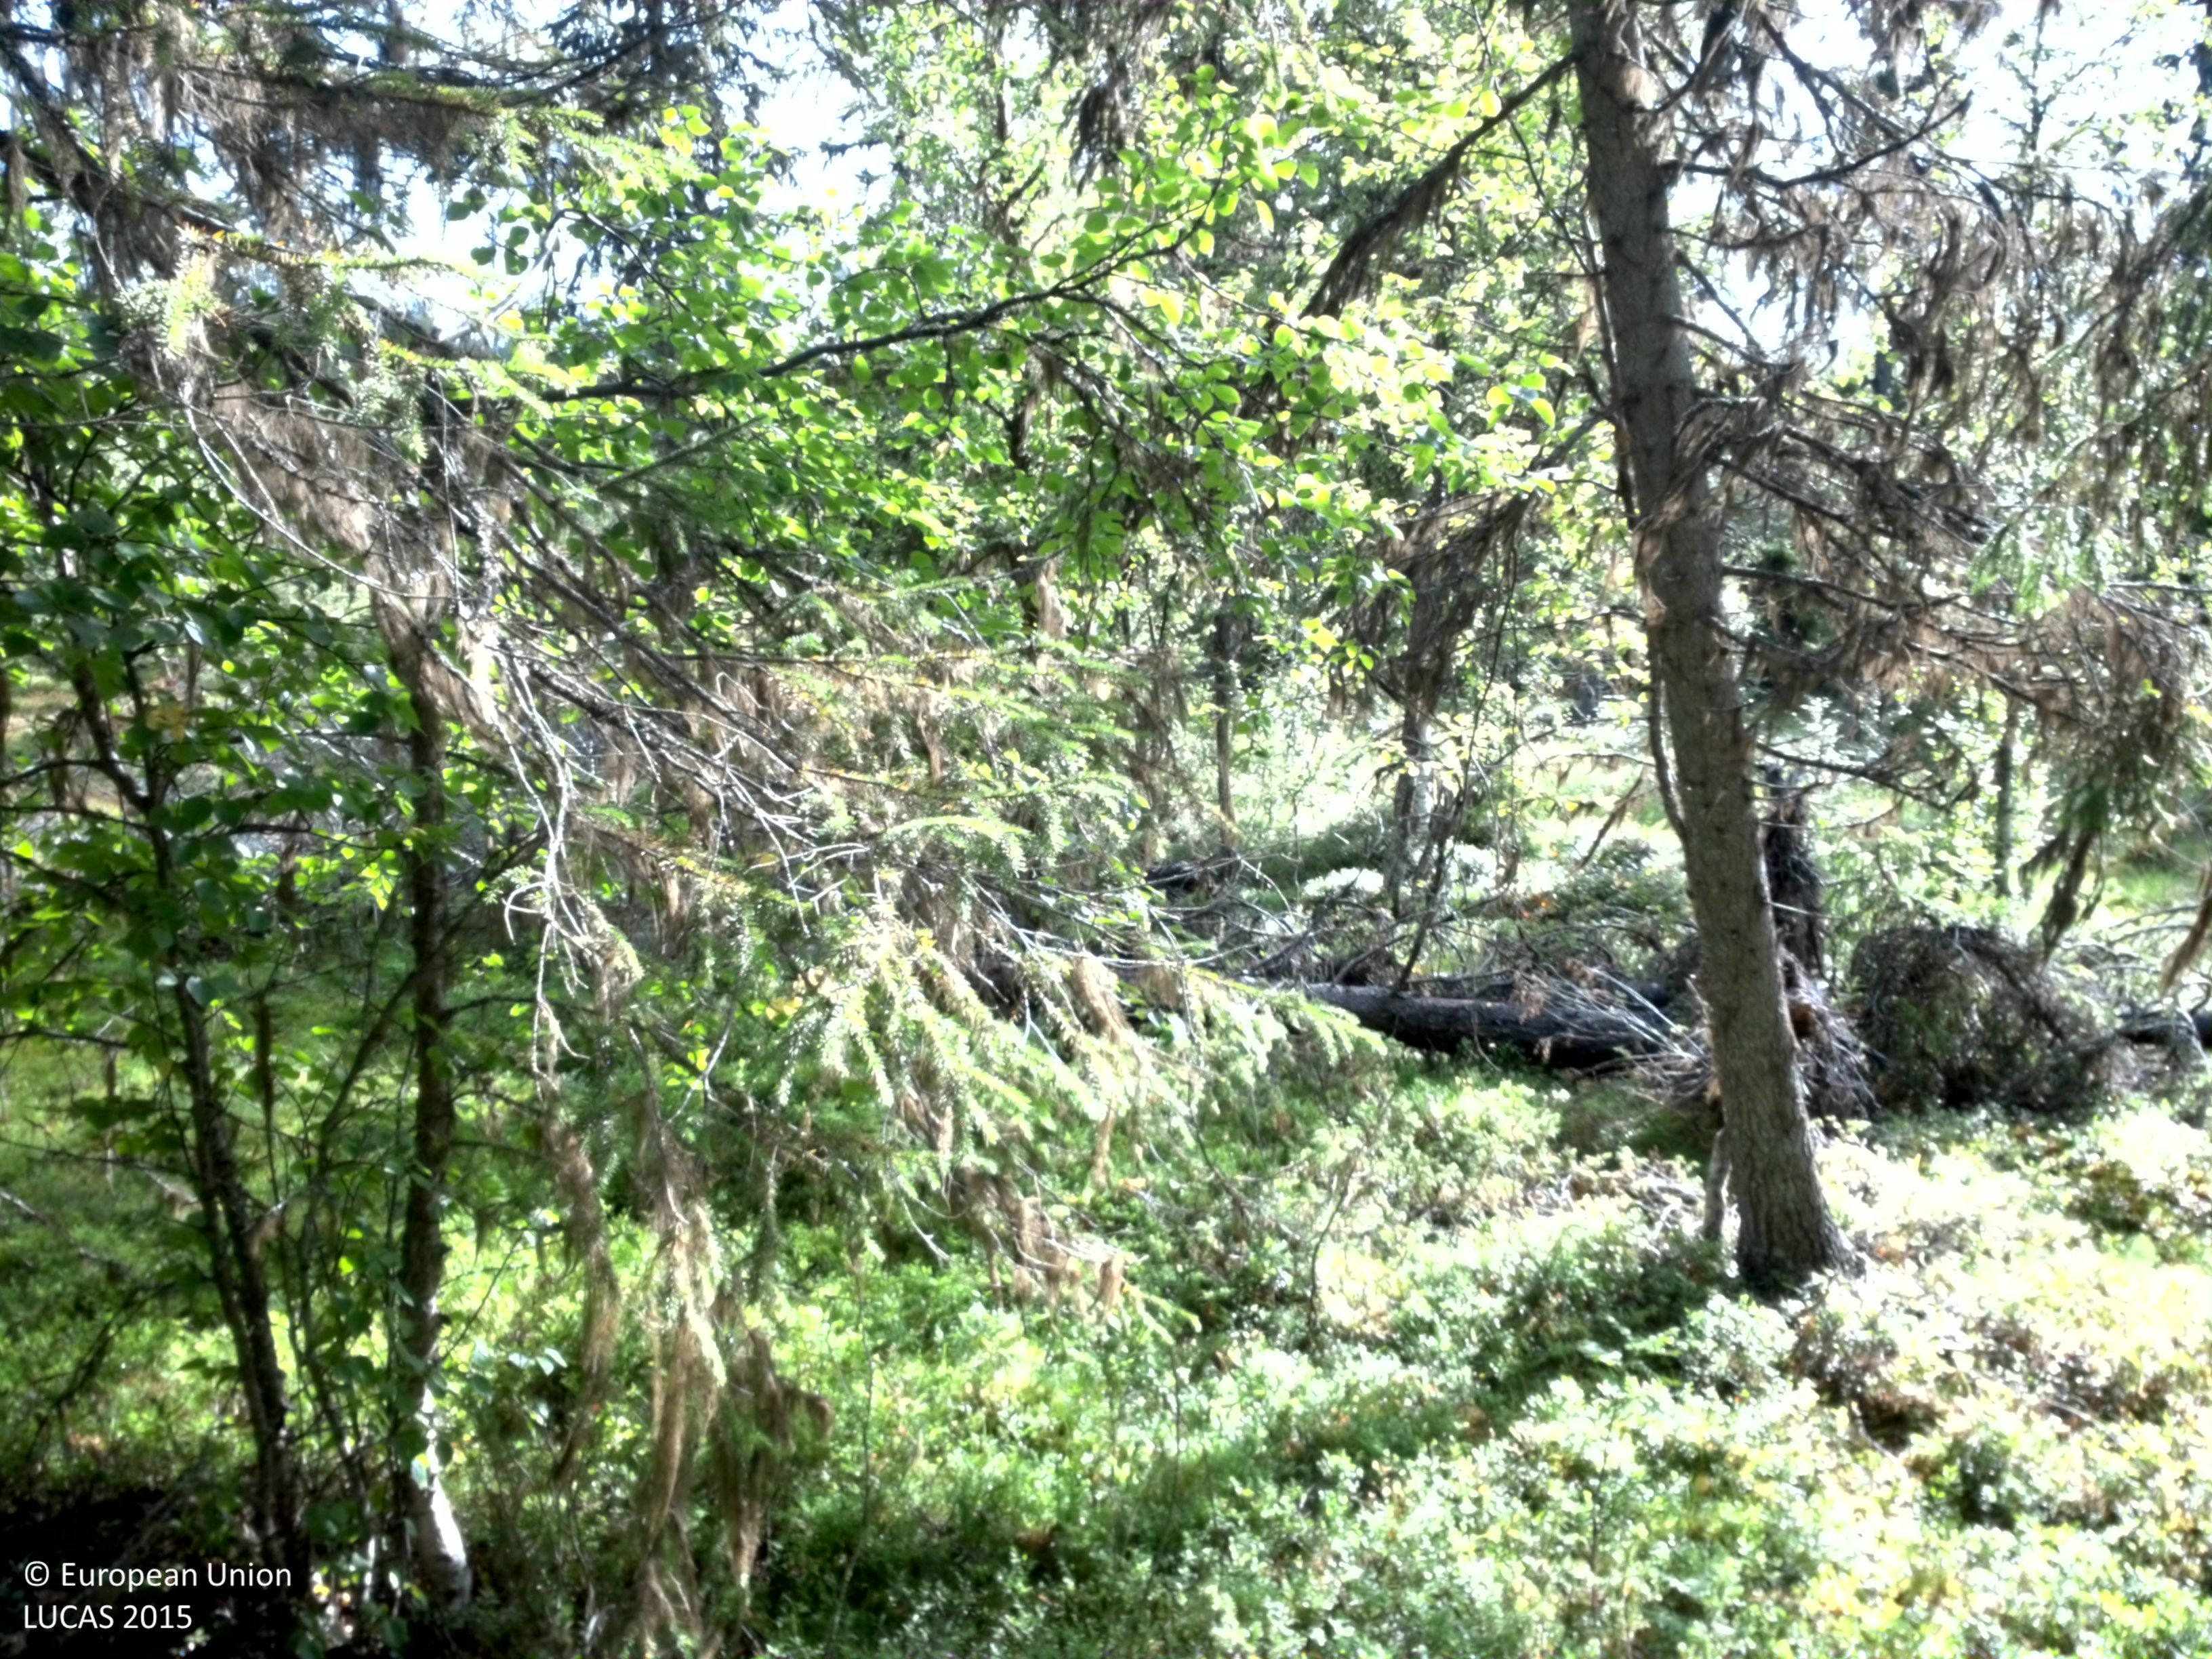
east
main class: Woodland
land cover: Spruce dominated mixed woodland
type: boreal forest
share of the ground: 25 - 50 %
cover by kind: shrubs 45 %, coniferous forest trees 30 %, broadleaved forest trees 15 %, herbaceous plants 5 %, lichens and mosses 5 %
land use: Forestry
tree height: > 5 m
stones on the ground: < 10 %
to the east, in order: Spruce dominated mixed woodland; Shrubland with sparse tree cover; Broadleaved woodland; Ditches and canals; Spruce dominated mixed woodland; Broadleaved woodland; Shruby margins; Paved roads, cycling and walking lanes; Shruby margins
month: August
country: SE
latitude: 64.8680
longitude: 16.8234
